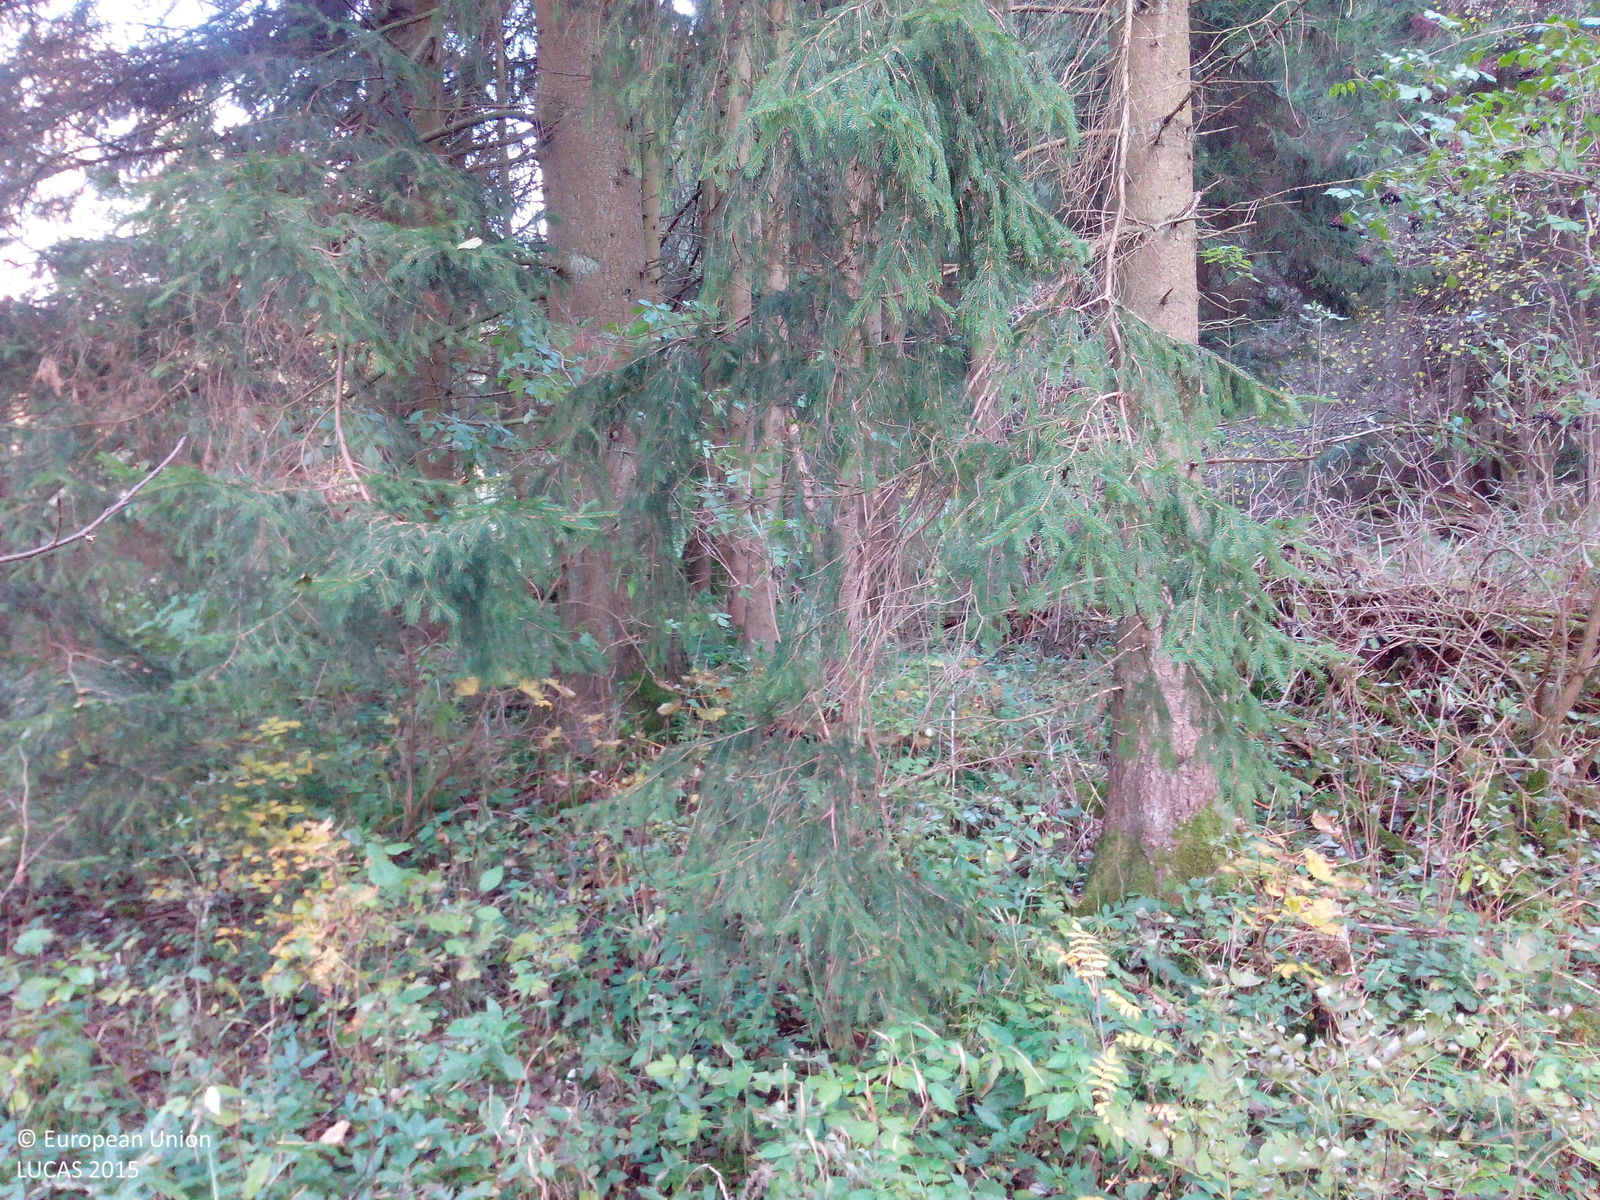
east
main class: Woodland
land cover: Broadleaved woodland
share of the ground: 50 - 75 %
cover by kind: broadleaved forest trees 45 %, coniferous forest trees 15 %, herbaceous plants 15 %, lichens and mosses 10 %, unconsolidated bare surface 10 %, shrubs 5 %
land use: Forestry
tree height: > 5 m
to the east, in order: Broadleaved woodland; Spruce dominated coniferous woodland; Grassland without tree/shrub cover; Spruce dominated coniferous woodland; Grassland without tree/shrub cover; Broadleaved woodland; Rivers and streams; Broadleaved woodland; Grassland without tree/shrub cover; Tracks; Grassland without tree/shrub cover; Other mixed woodland
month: October
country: DE
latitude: 50.3820
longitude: 9.9297
